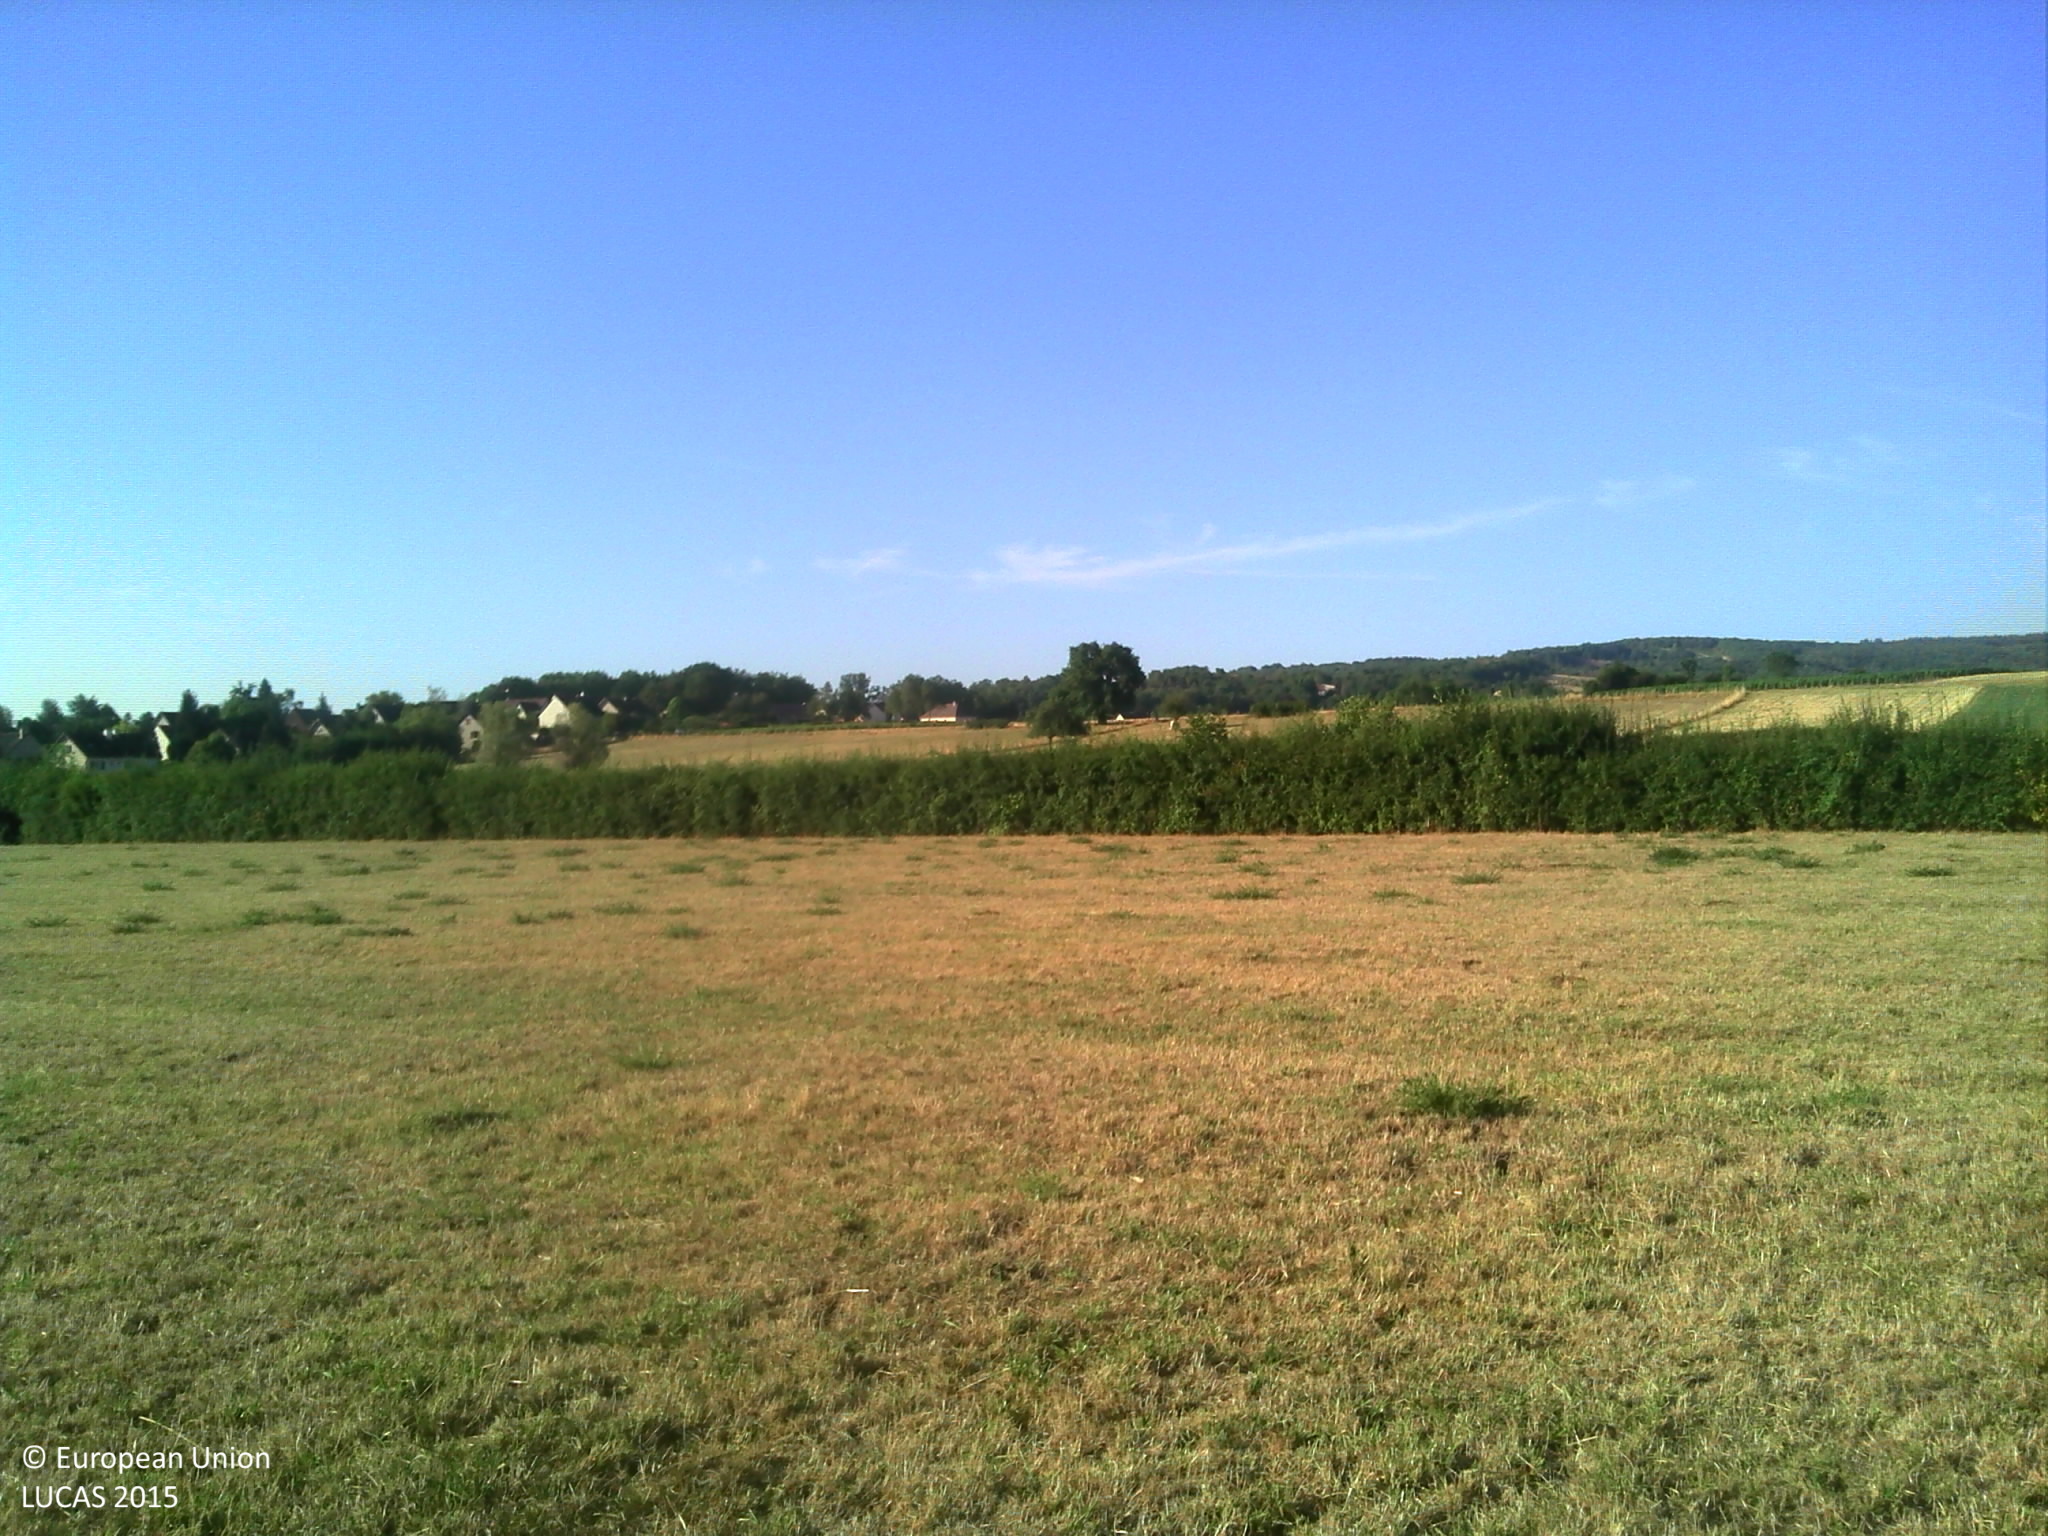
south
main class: Grassland
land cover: Grassland without tree/shrub cover
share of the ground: > 75 %
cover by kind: herbaceous plants 100 %
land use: Agriculture (excluding fallow land and kitchen gardens)
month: August
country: FR
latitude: 46.8176
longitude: 4.7453
